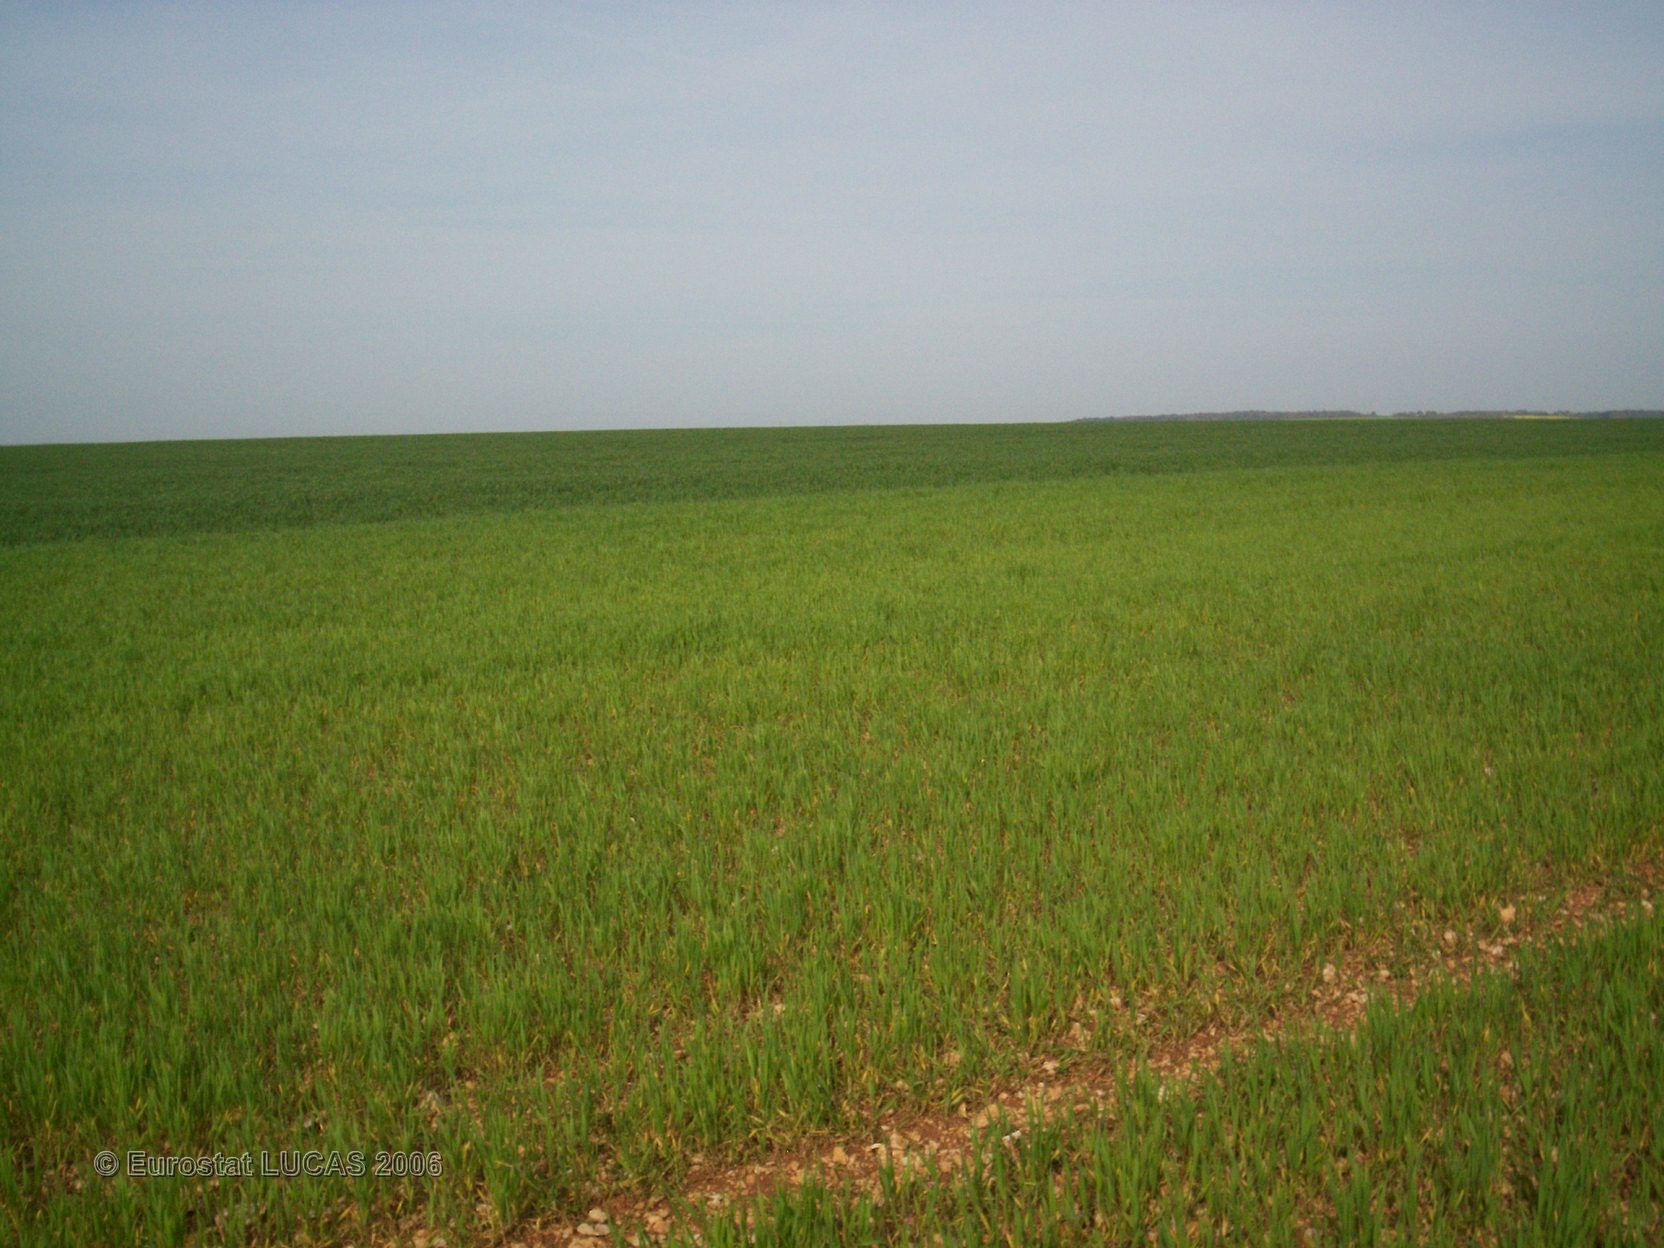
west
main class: Cropland
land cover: Common wheat
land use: Agriculture (excluding fallow land and kitchen gardens)
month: May
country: FR
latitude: 47.5650
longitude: 4.5362
